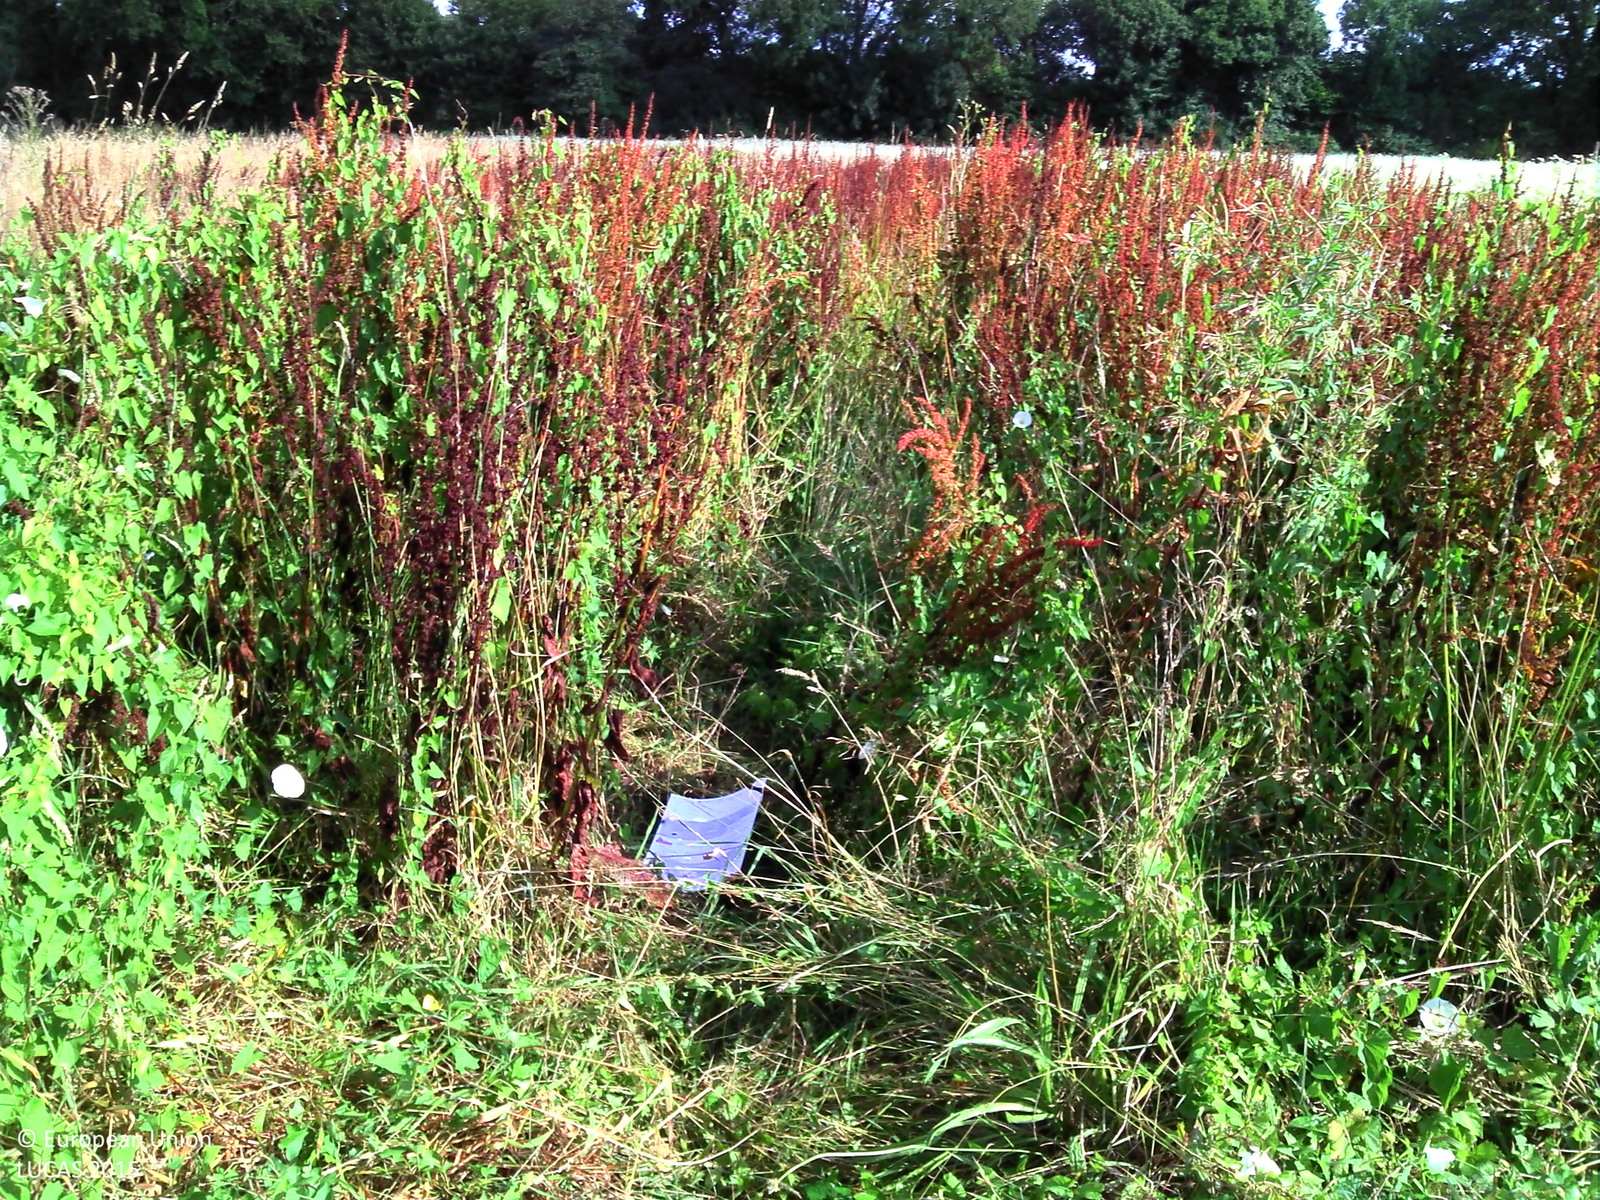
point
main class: Grassland
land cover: Spontaneously vegetated surfaces
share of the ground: > 75 %
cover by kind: herbaceous plants 80 %, consolidated bare surface 10 %, unconsolidated bare surface 10 %
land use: Fallow land
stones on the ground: < 10 %
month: July
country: FR
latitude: 47.7830
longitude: -3.1084
